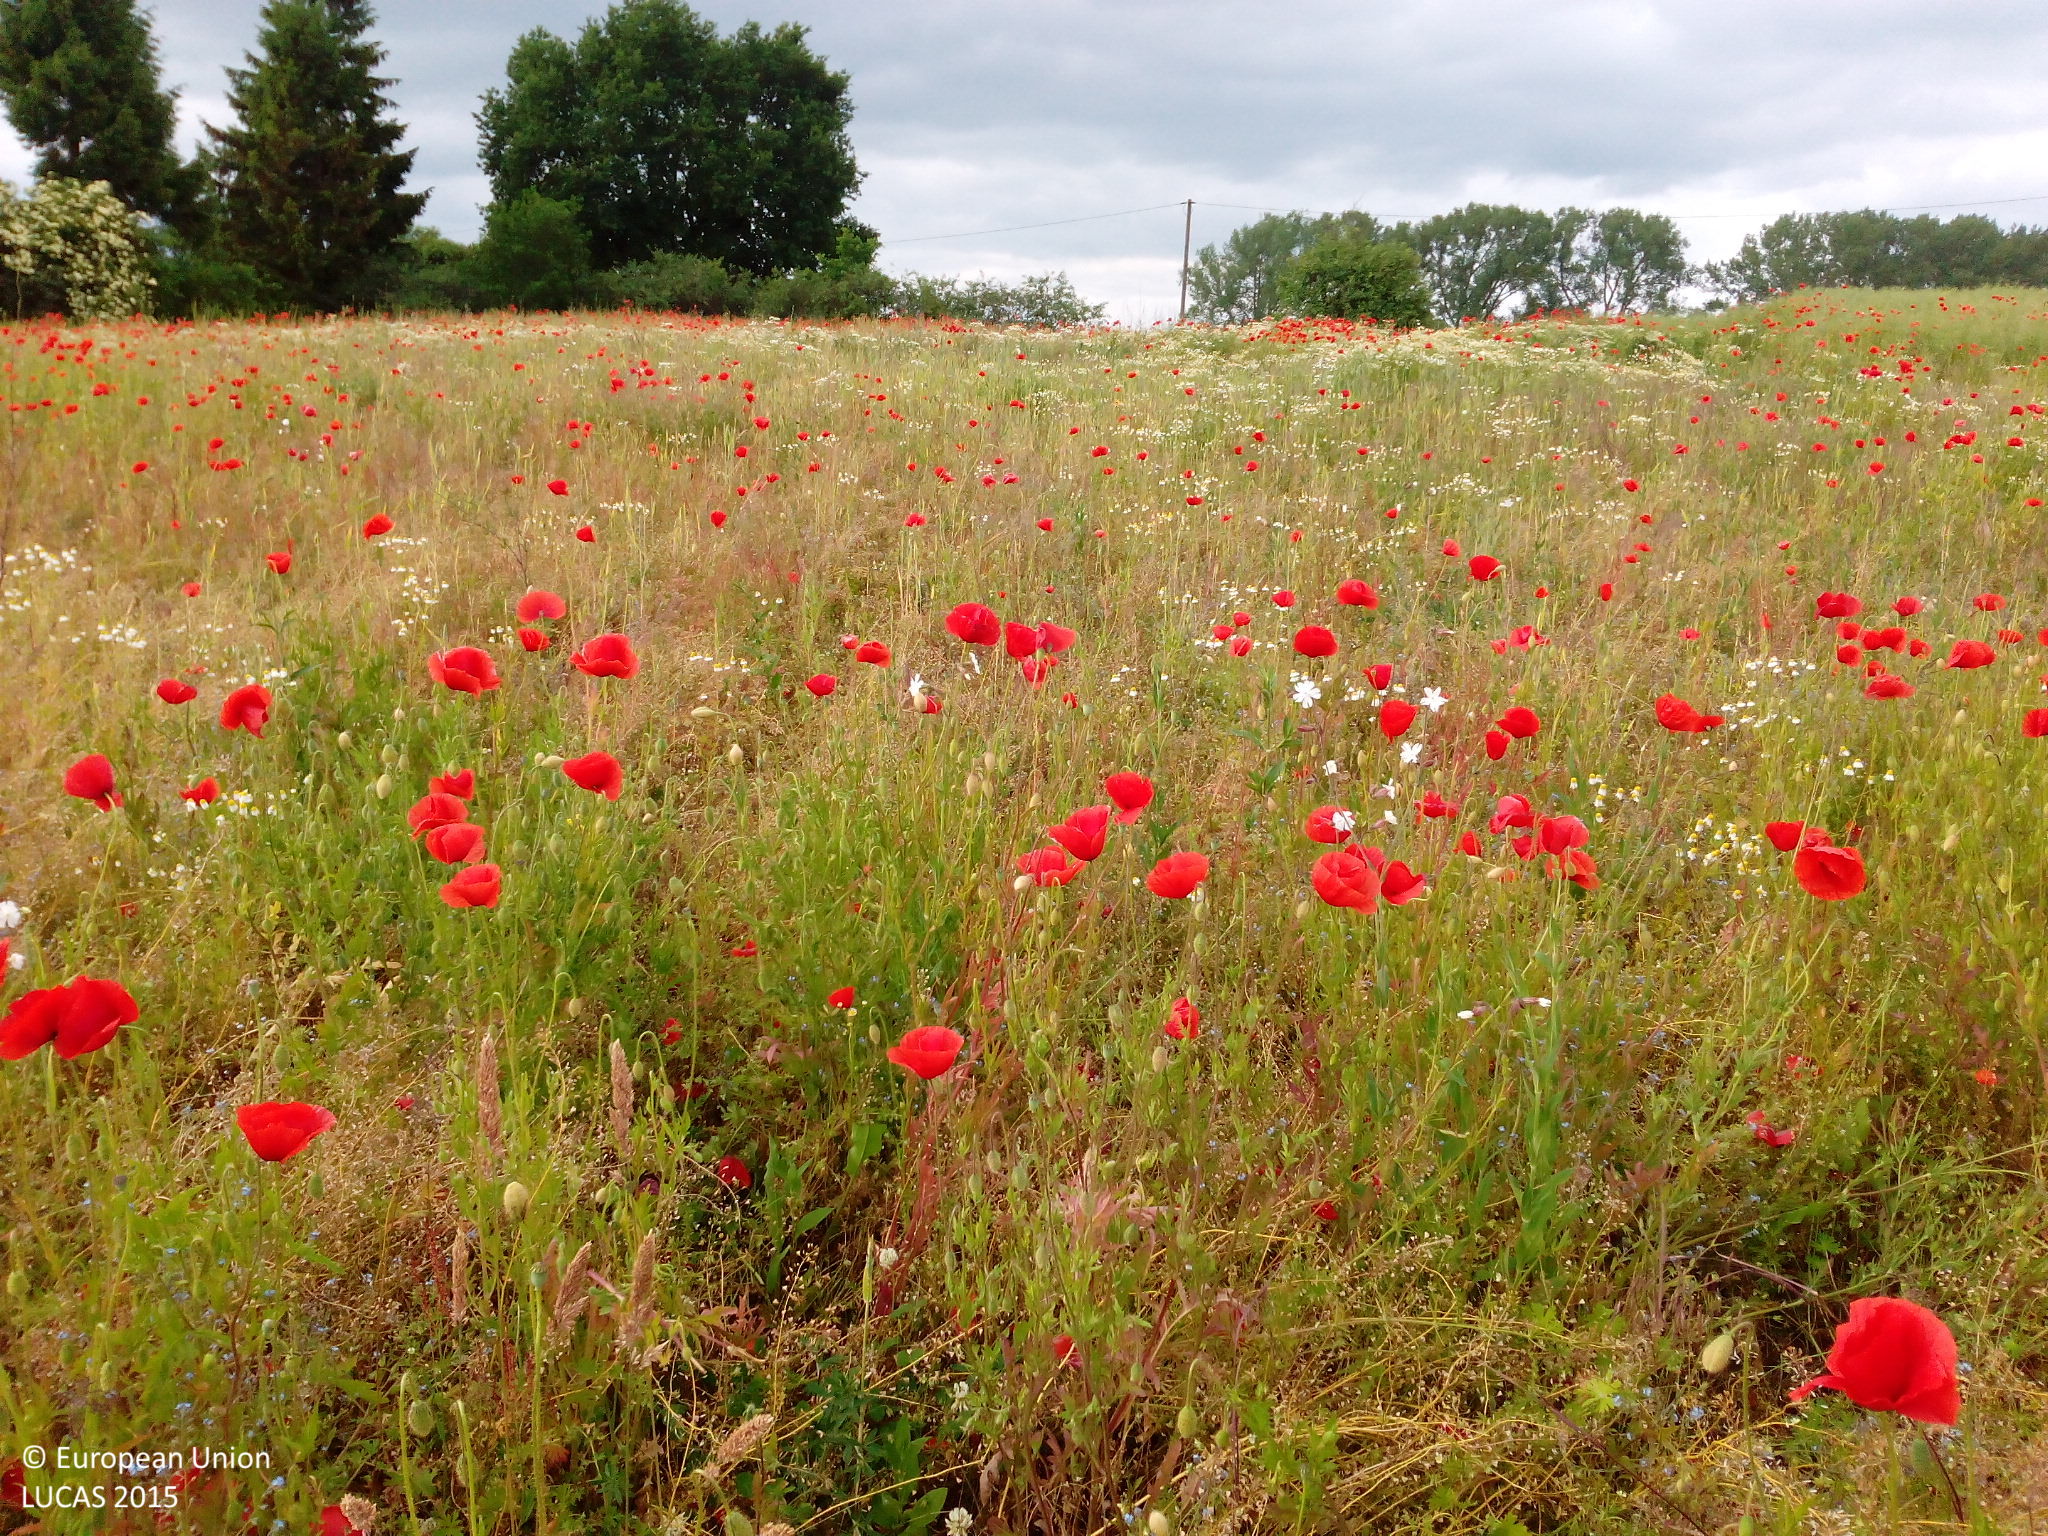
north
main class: Grassland
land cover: Grassland without tree/shrub cover
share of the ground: > 75 %
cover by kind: herbaceous plants 100 %
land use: Agriculture (excluding fallow land and kitchen gardens)
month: June
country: DE
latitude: 53.6665
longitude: 11.1043
